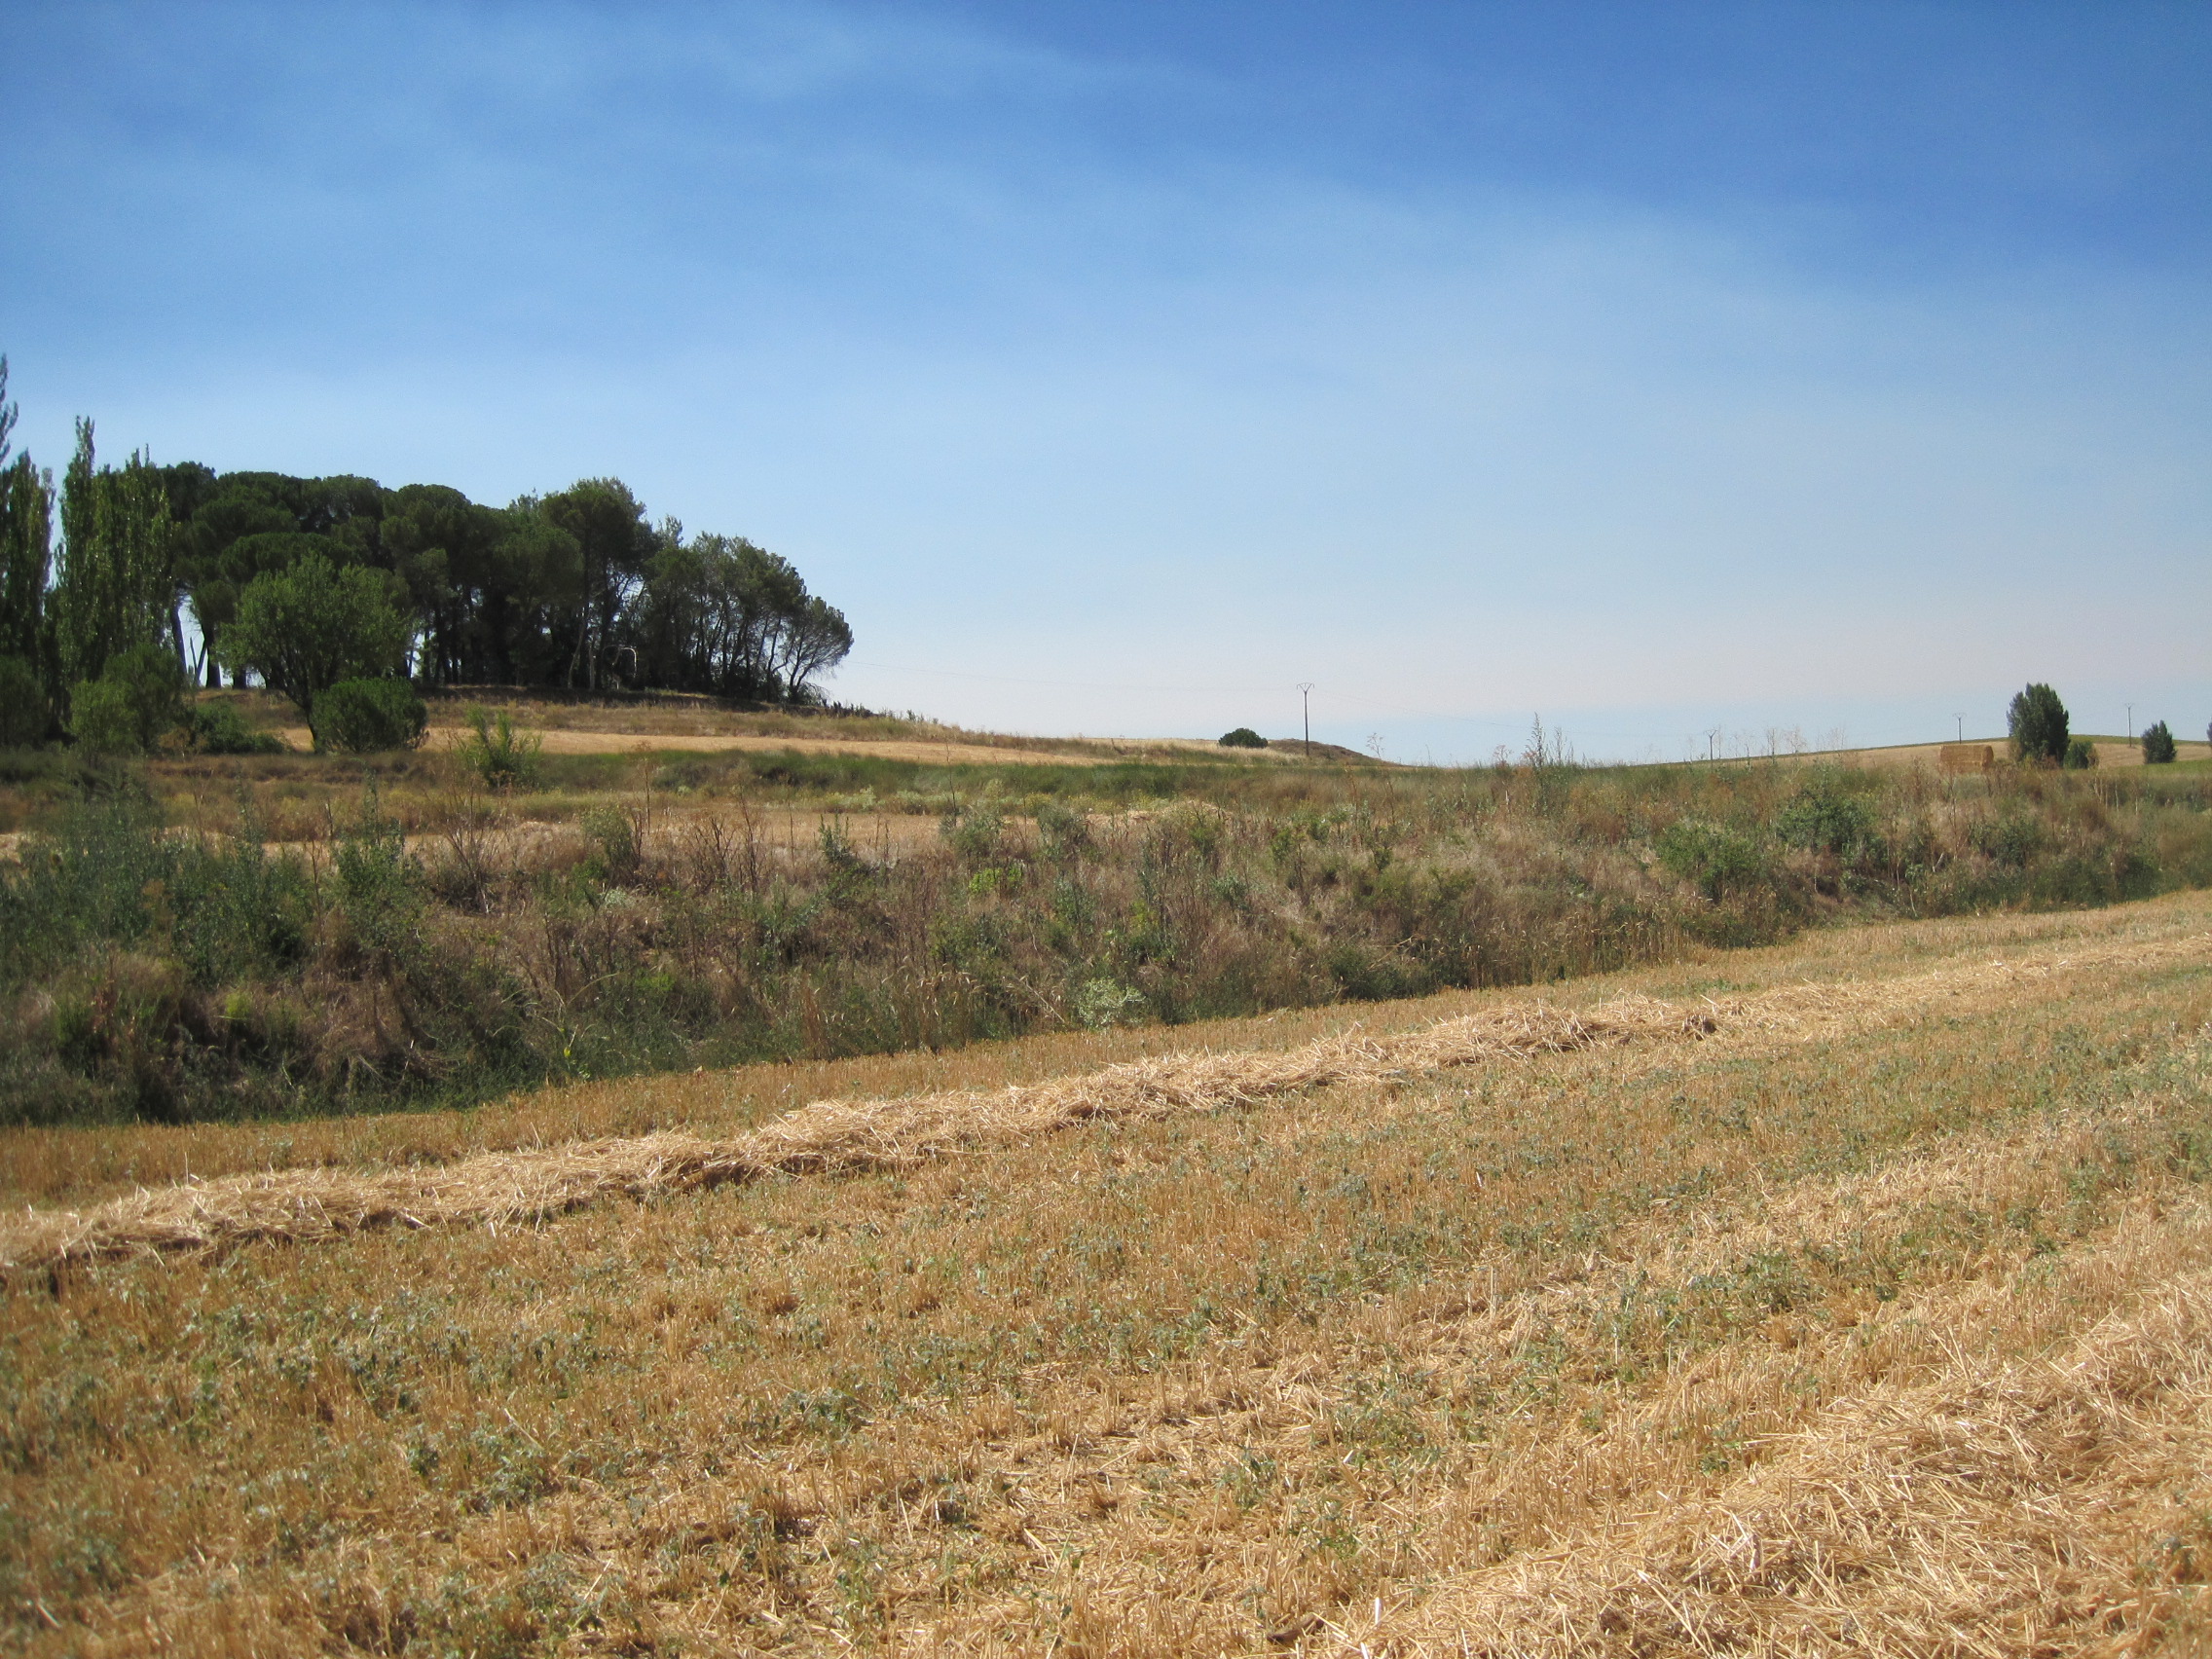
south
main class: Cropland
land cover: Common wheat
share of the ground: < 10 %
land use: Agriculture (excluding fallow land and kitchen gardens)
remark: Harvested field
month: July
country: ES
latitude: 42.1448
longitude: -5.2960
